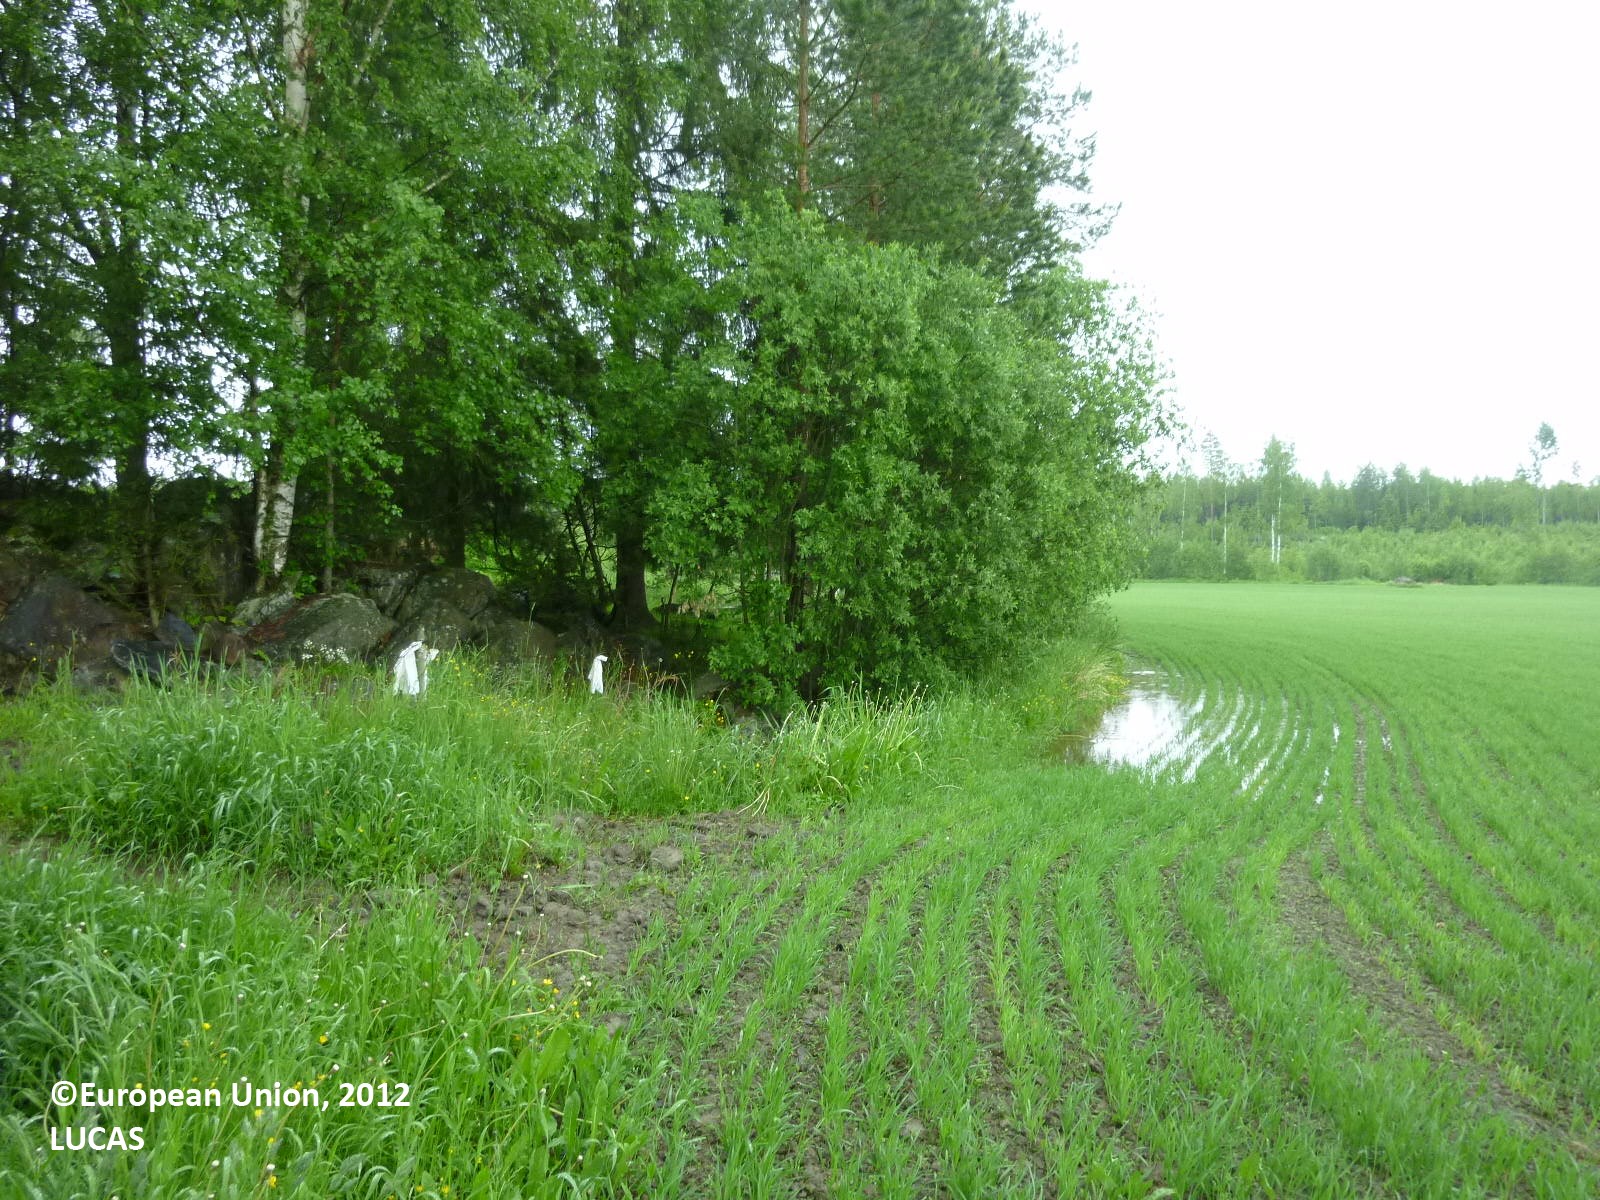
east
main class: Cropland
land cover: Oats
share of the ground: > 75 %
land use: Agriculture (excluding fallow land and kitchen gardens)
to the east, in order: Oats; Grass margins; Ditches and canals; Abandoned hedges; Grassland without tree/shrub cover; Shrubland with sparse tree cover
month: June
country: FI
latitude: 61.5387
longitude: 22.3058
